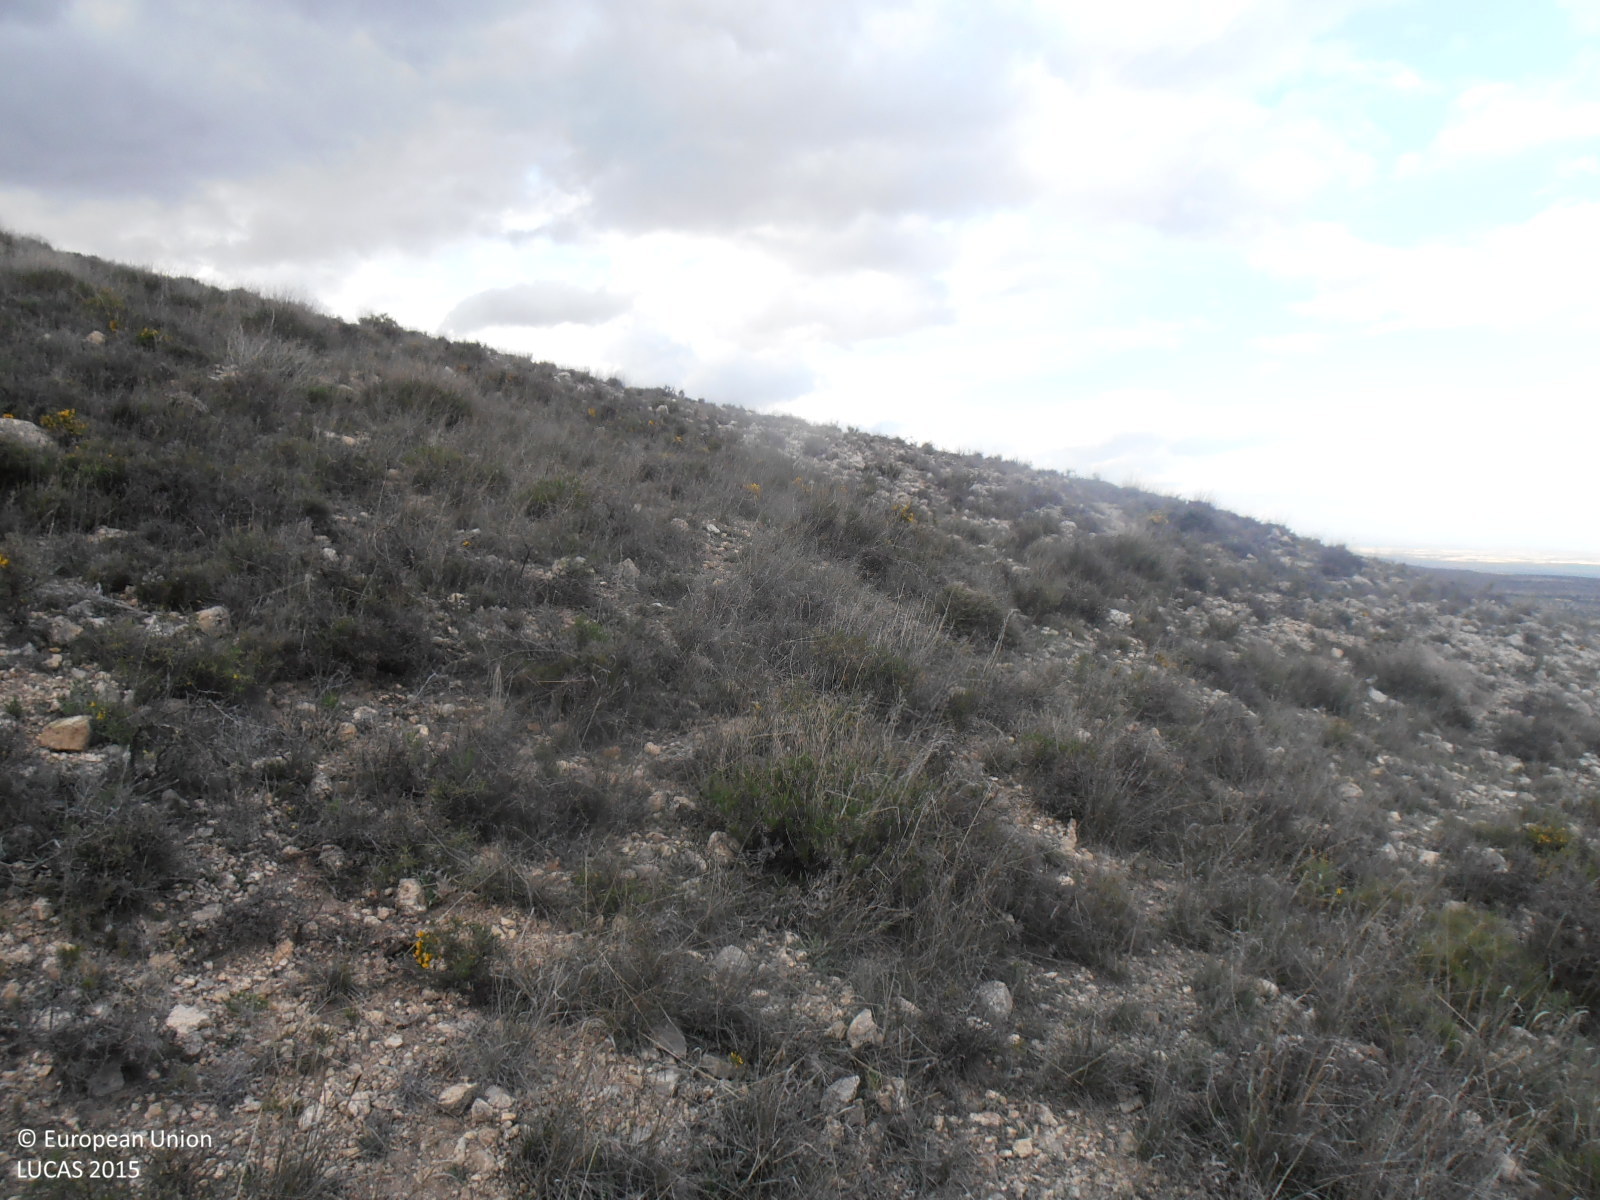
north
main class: Shrubland
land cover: Shrubland without tree cover
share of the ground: 50 - 75 %
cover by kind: shrubs 50 %, consolidated bare surface 40 %, herbaceous plants 10 %
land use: Semi-natural and natural areas not in use
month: April
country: ES
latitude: 41.1563
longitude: -0.7052
